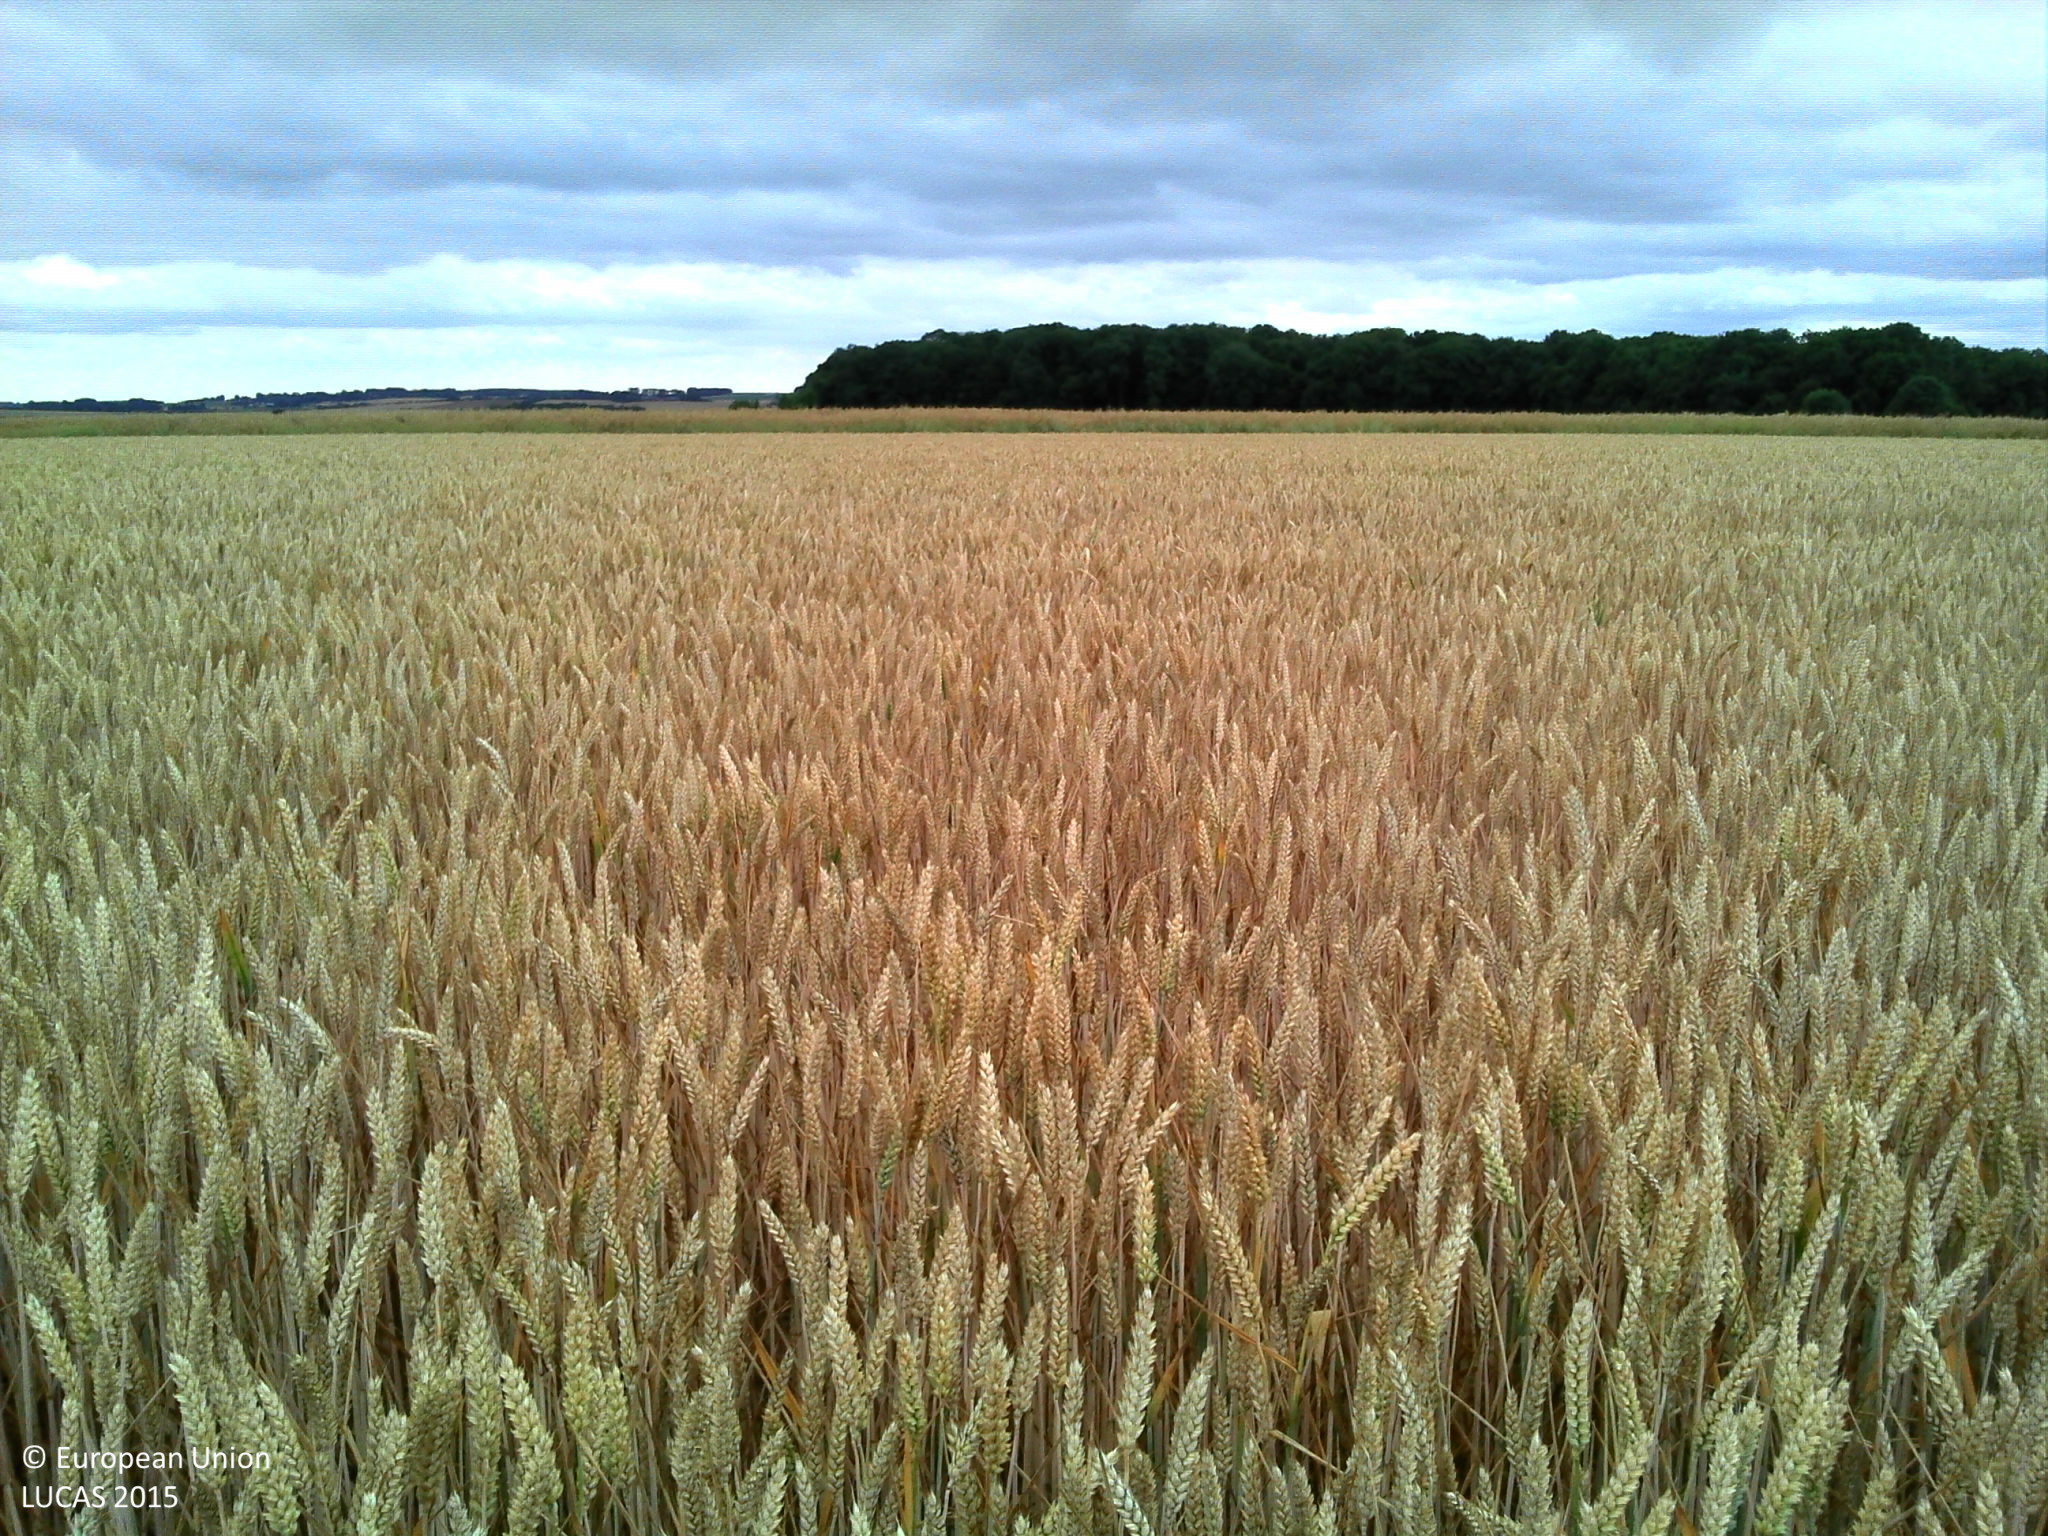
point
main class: Cropland
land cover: Common wheat
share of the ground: > 75 %
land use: Agriculture (excluding fallow land and kitchen gardens)
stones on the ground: < 10 %
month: July
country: FR
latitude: 50.0365
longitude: 3.2198
